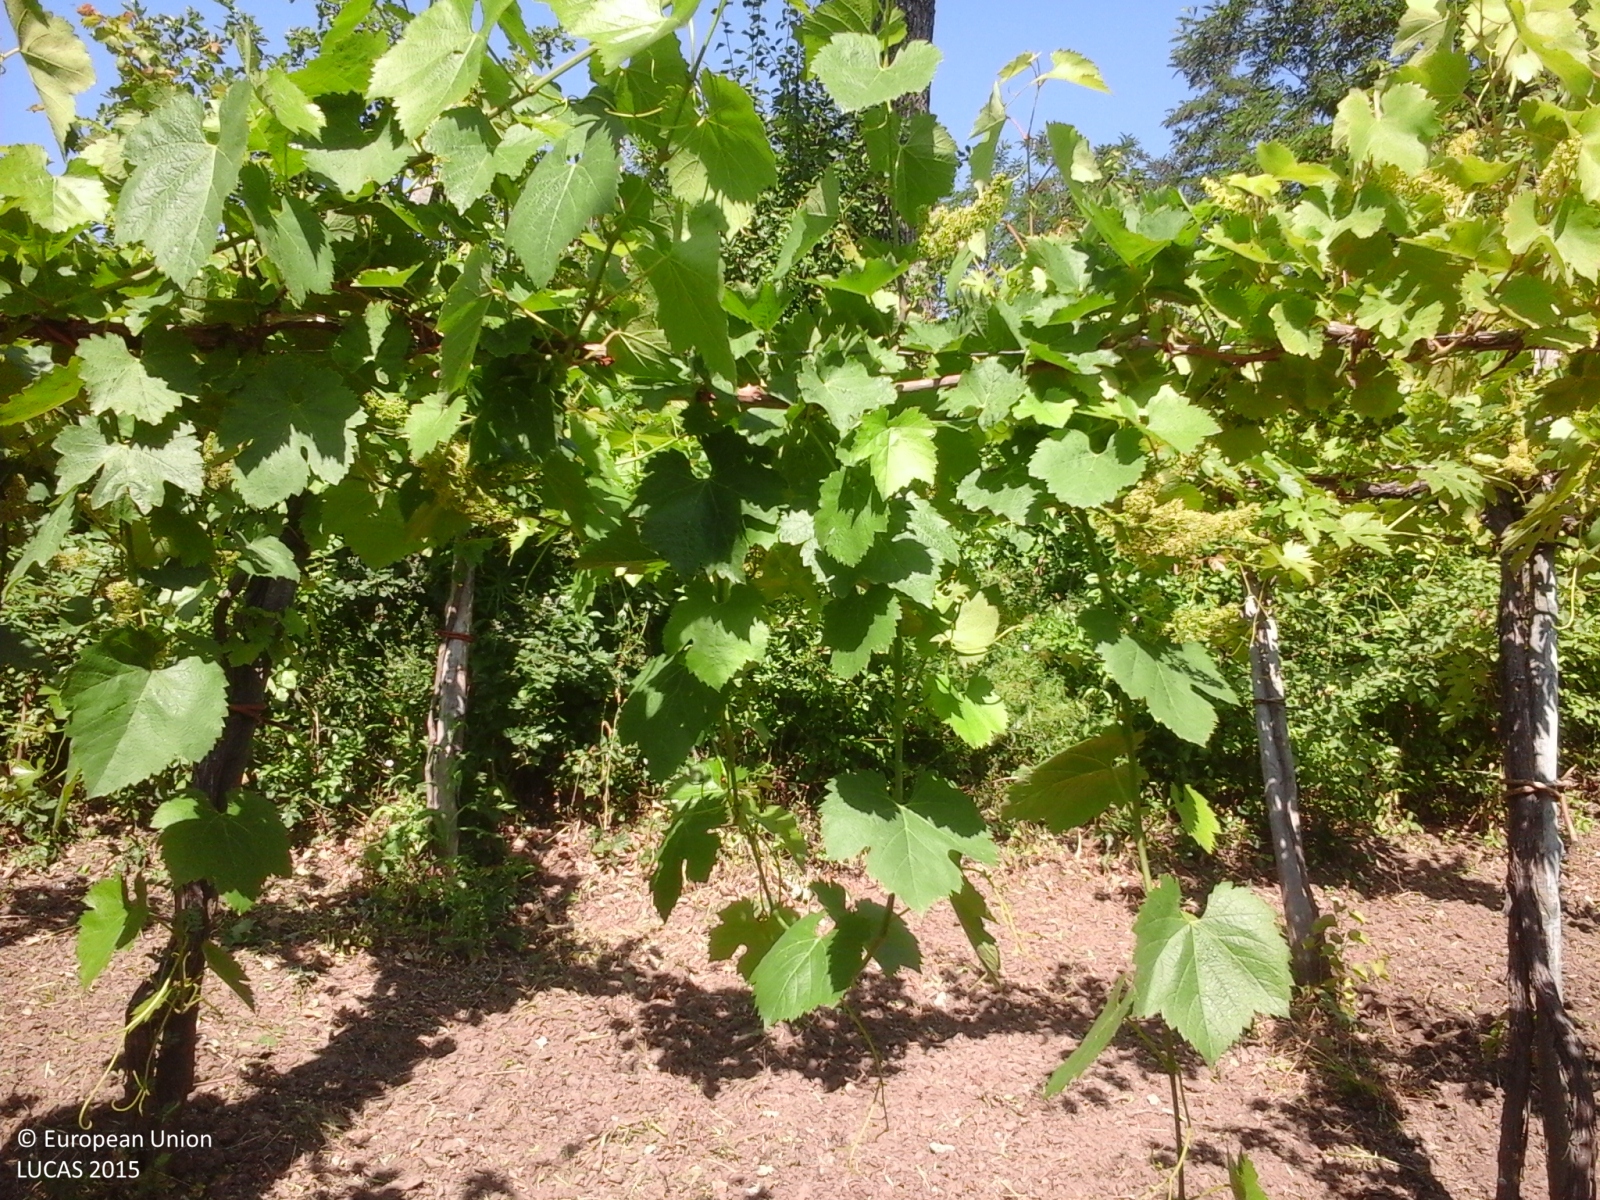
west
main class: Cropland
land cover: Vineyards
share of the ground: > 75 %
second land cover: Other bare soil
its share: > 75 %
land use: Agriculture (excluding fallow land and kitchen gardens)
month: June
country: IT
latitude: 41.1698
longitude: 14.6903
